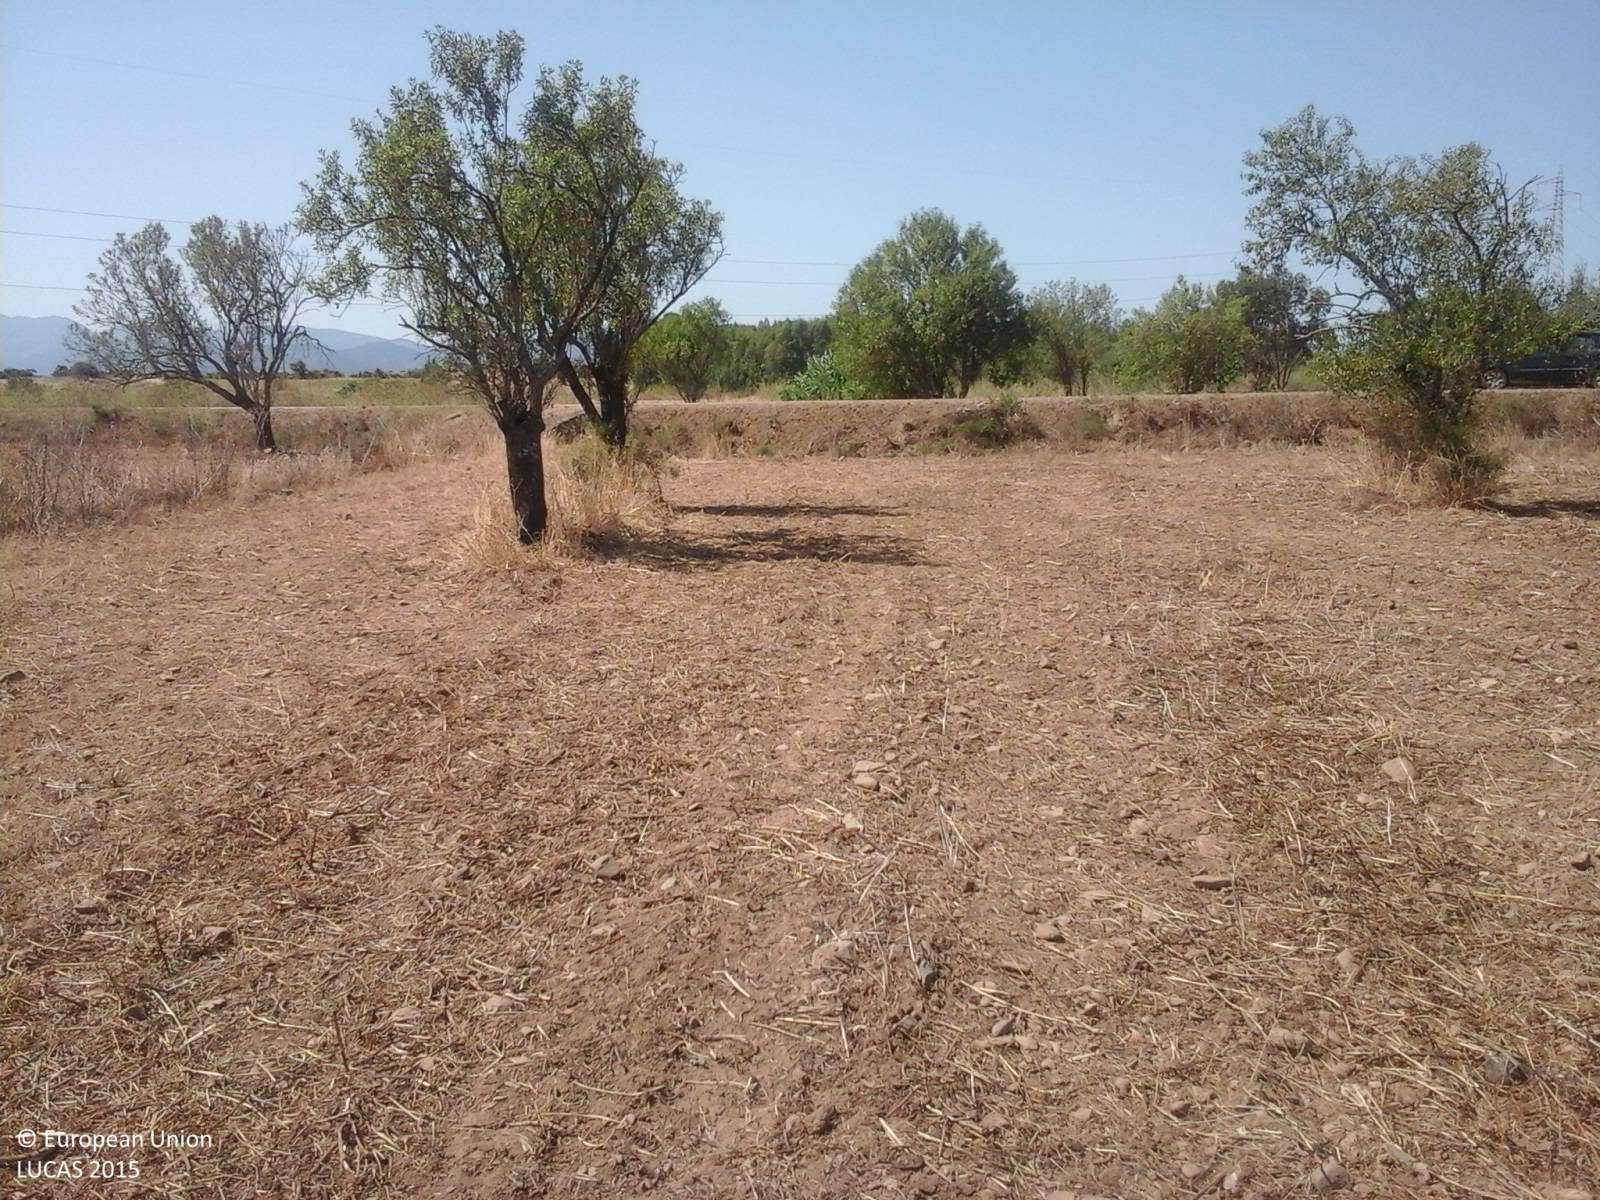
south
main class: Cropland
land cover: Mixed cereals for fodder
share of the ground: > 75 %
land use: Agriculture (excluding fallow land and kitchen gardens)
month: August
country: IT
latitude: 39.3545
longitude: 8.8119
